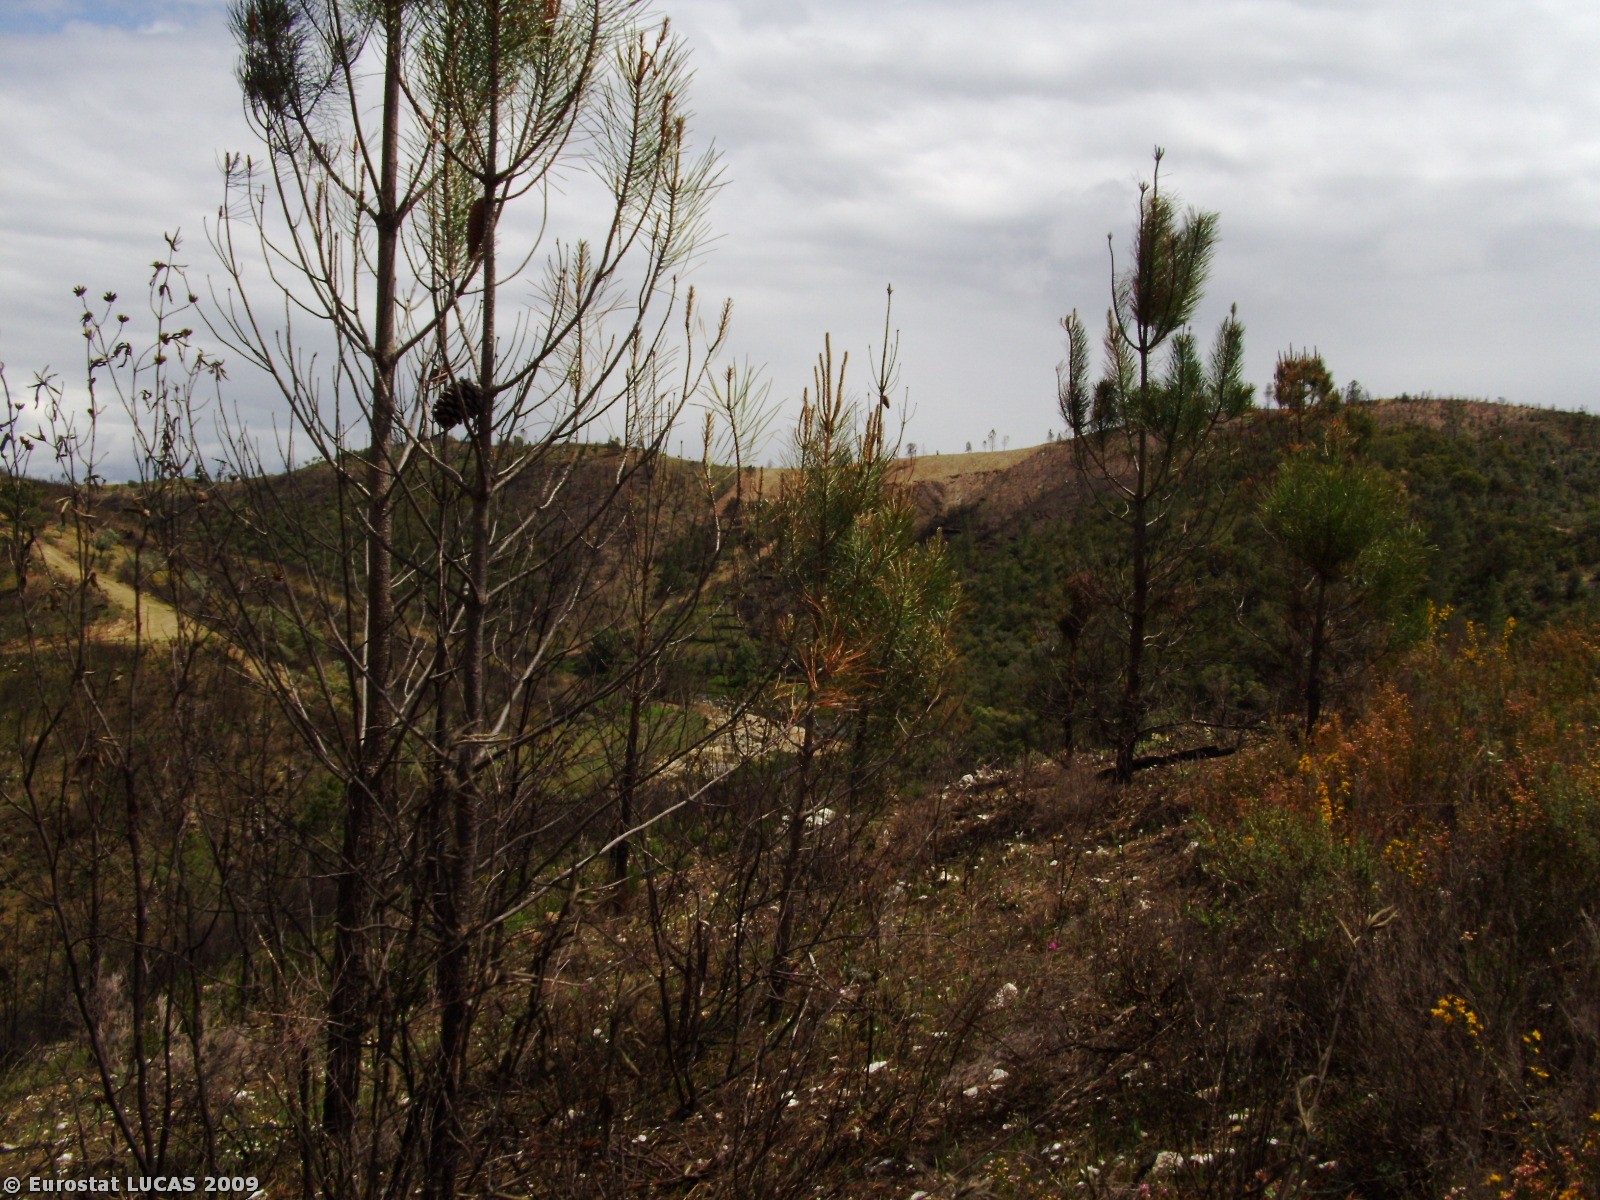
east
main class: Woodland
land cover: Coniferous woodland
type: coniferous forest of the mediterranean region
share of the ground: 50 - 75 %
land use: Forestry
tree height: > 5 m
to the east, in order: Coniferous woodland; Rivers and streams; Tracks; Shrubland without tree cover; Tracks; Shrubland with sparse tree cover
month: April
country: PT
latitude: 39.8226
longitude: -7.6150
